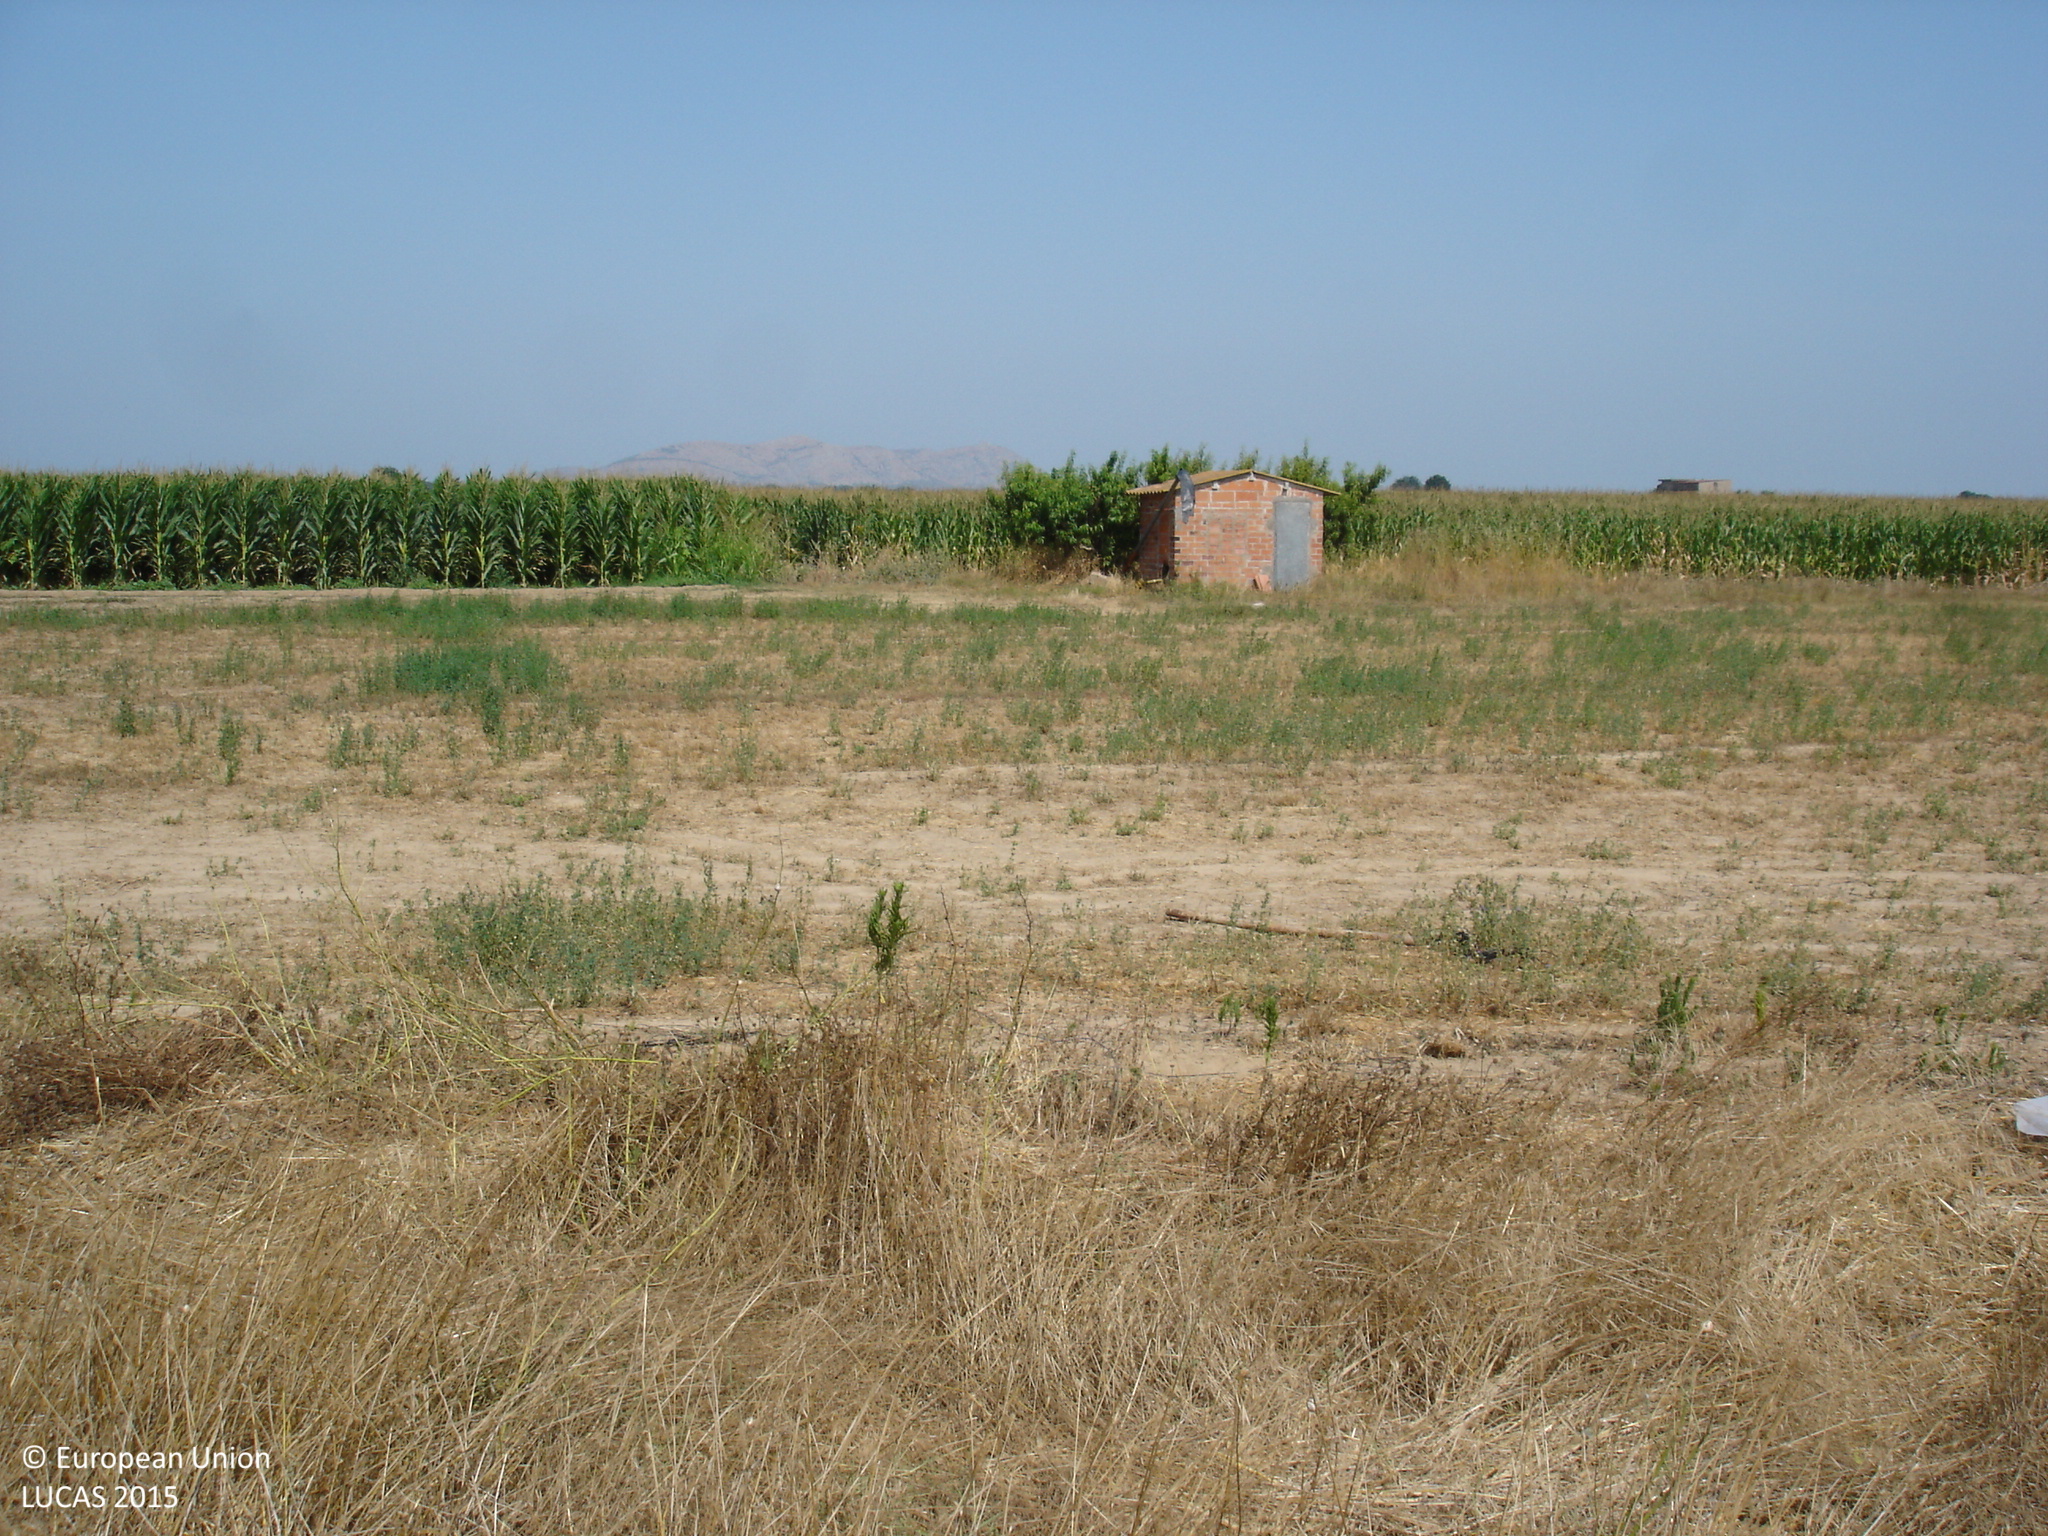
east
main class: Cropland
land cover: Maize
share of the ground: 10 - 25 %
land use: Agriculture (excluding fallow land and kitchen gardens)
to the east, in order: Maize; Grass margins; Lucerne; Tracks; Grass margins; Maize
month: July
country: ES
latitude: 42.0506
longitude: 3.0197
